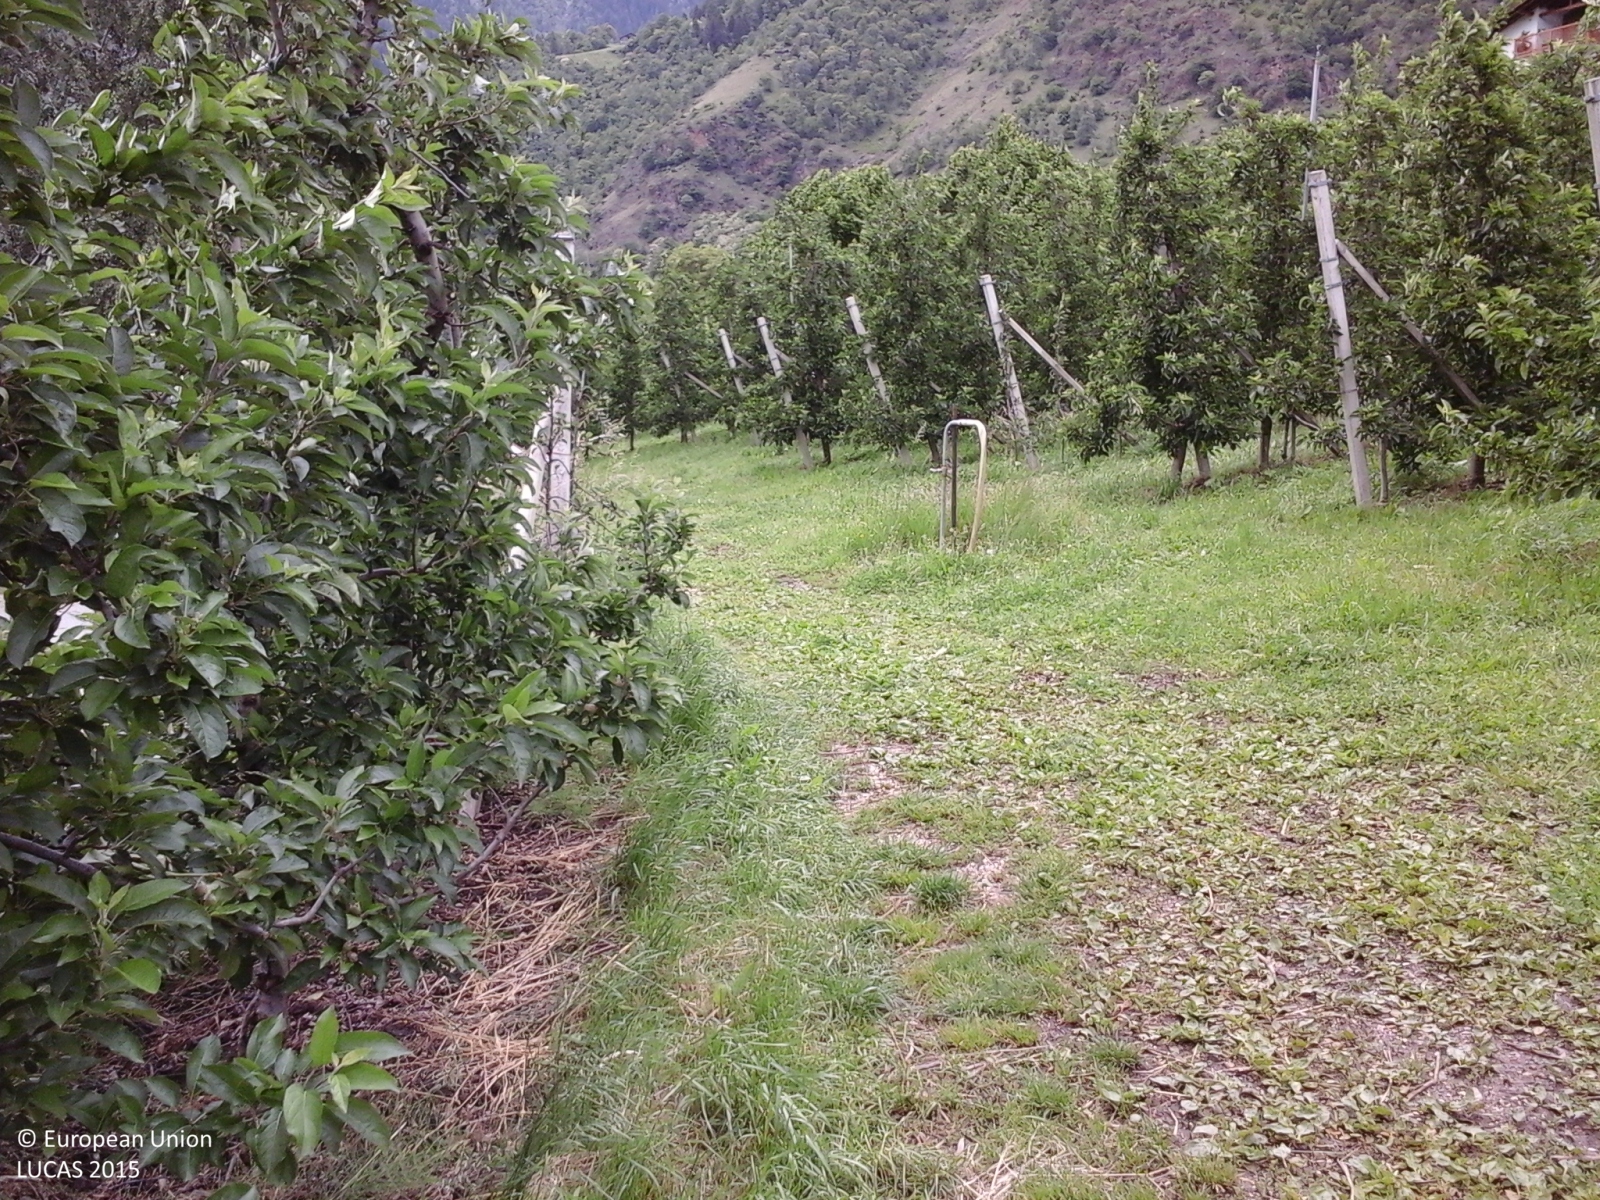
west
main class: Cropland
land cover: Apple fruit
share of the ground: > 75 %
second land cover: Grassland without tree/shrub cover
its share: > 75 %
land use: Agriculture (excluding fallow land and kitchen gardens)
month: May
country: IT
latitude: 46.6879
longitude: 11.0840
